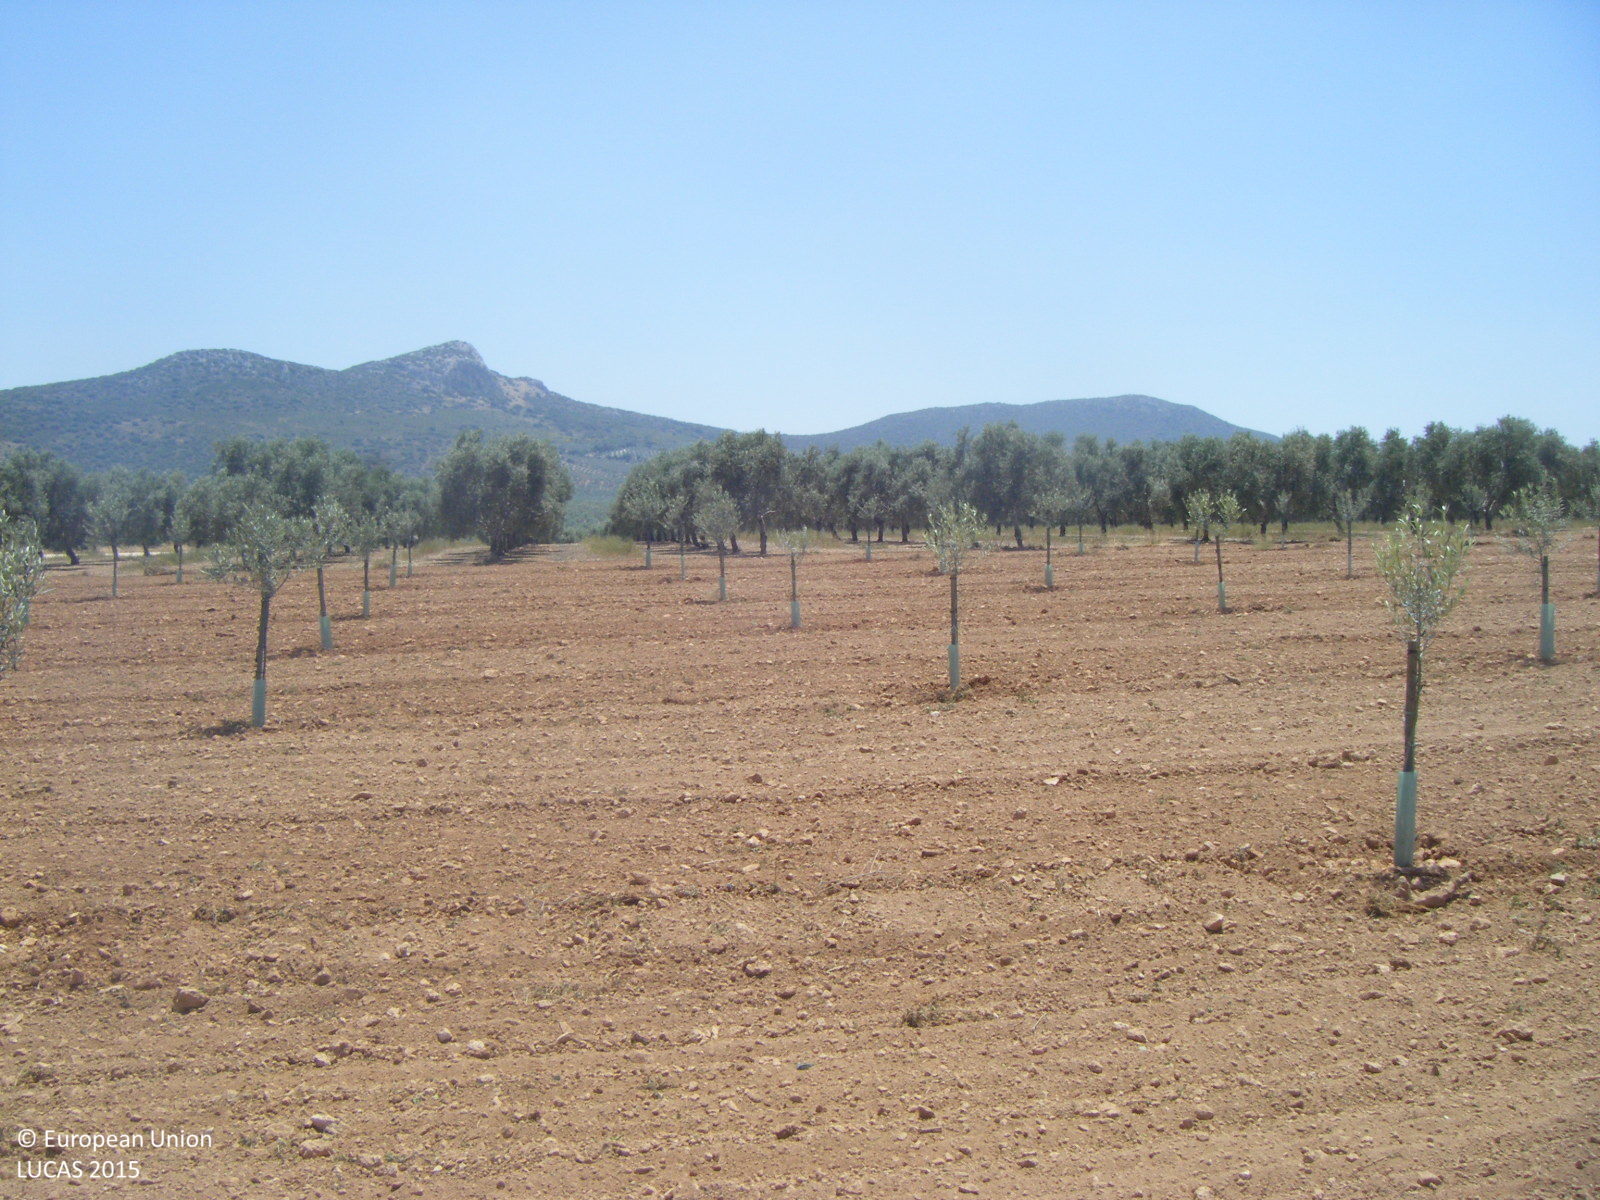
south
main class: Cropland
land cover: Olive groves
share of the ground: < 10 %
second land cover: Other bare soil
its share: > 75 %
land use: Agriculture (excluding fallow land and kitchen gardens)
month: May
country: ES
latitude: 37.2796
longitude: -4.8130
